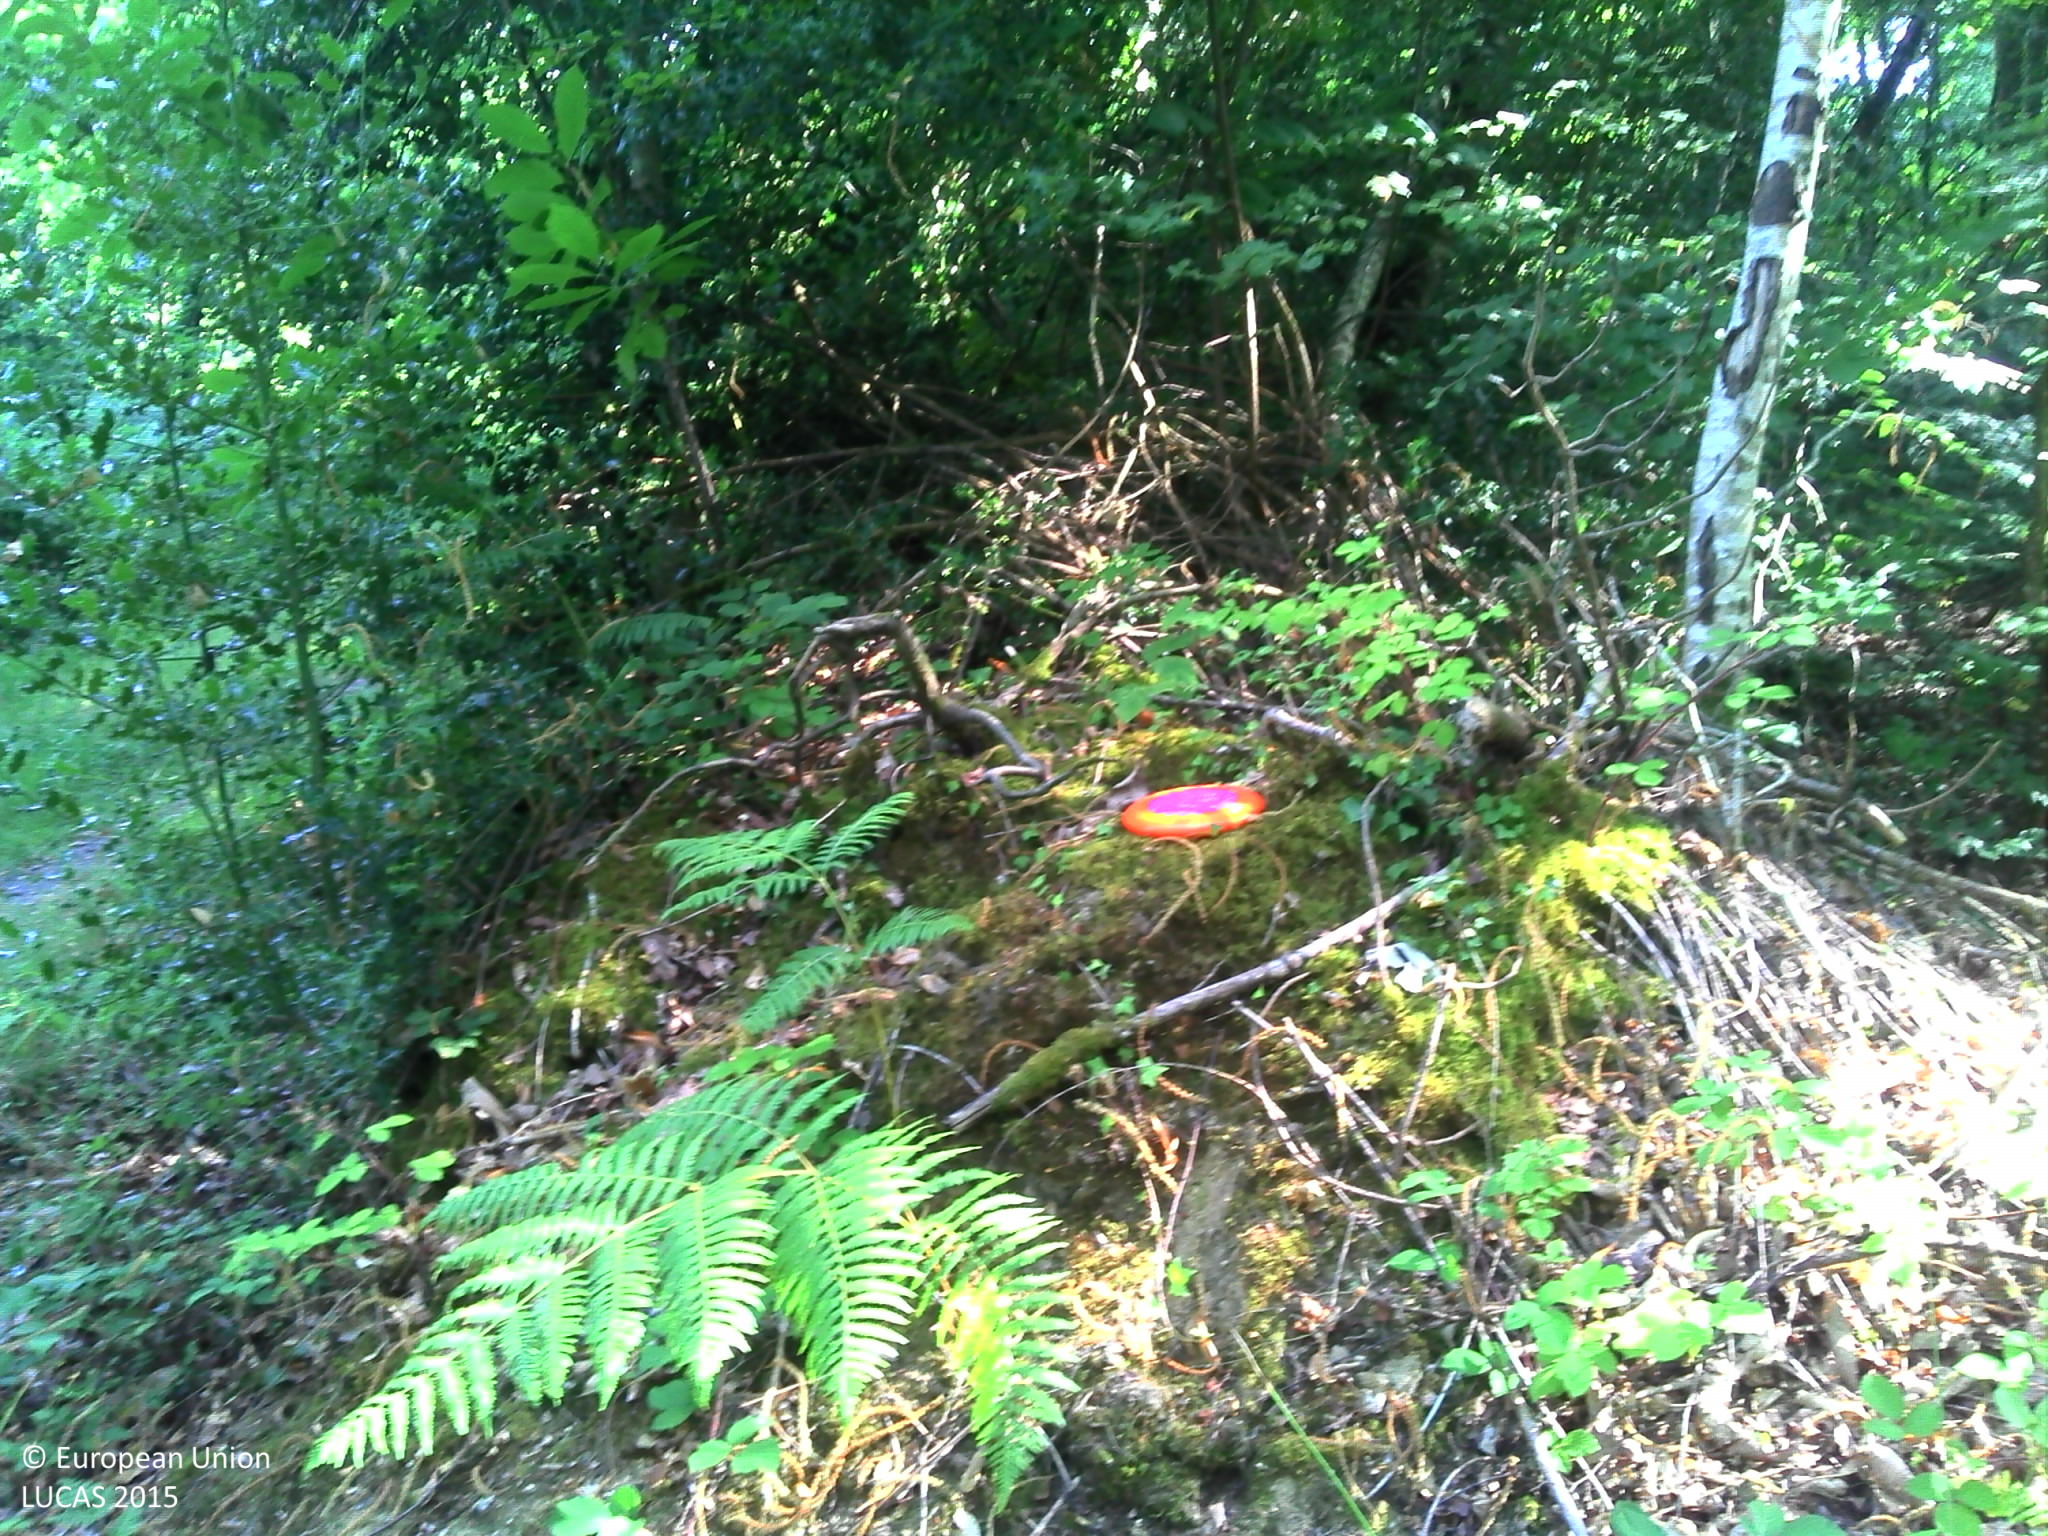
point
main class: Woodland
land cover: Broadleaved woodland
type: mesophytic deciduous forest
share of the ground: > 75 %
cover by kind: broadleaved forest trees 80 %, shrubs 10 %, herbaceous plants 10 %
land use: Forestry
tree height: > 5 m
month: July
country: FR
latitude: 47.7847
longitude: -3.2447
